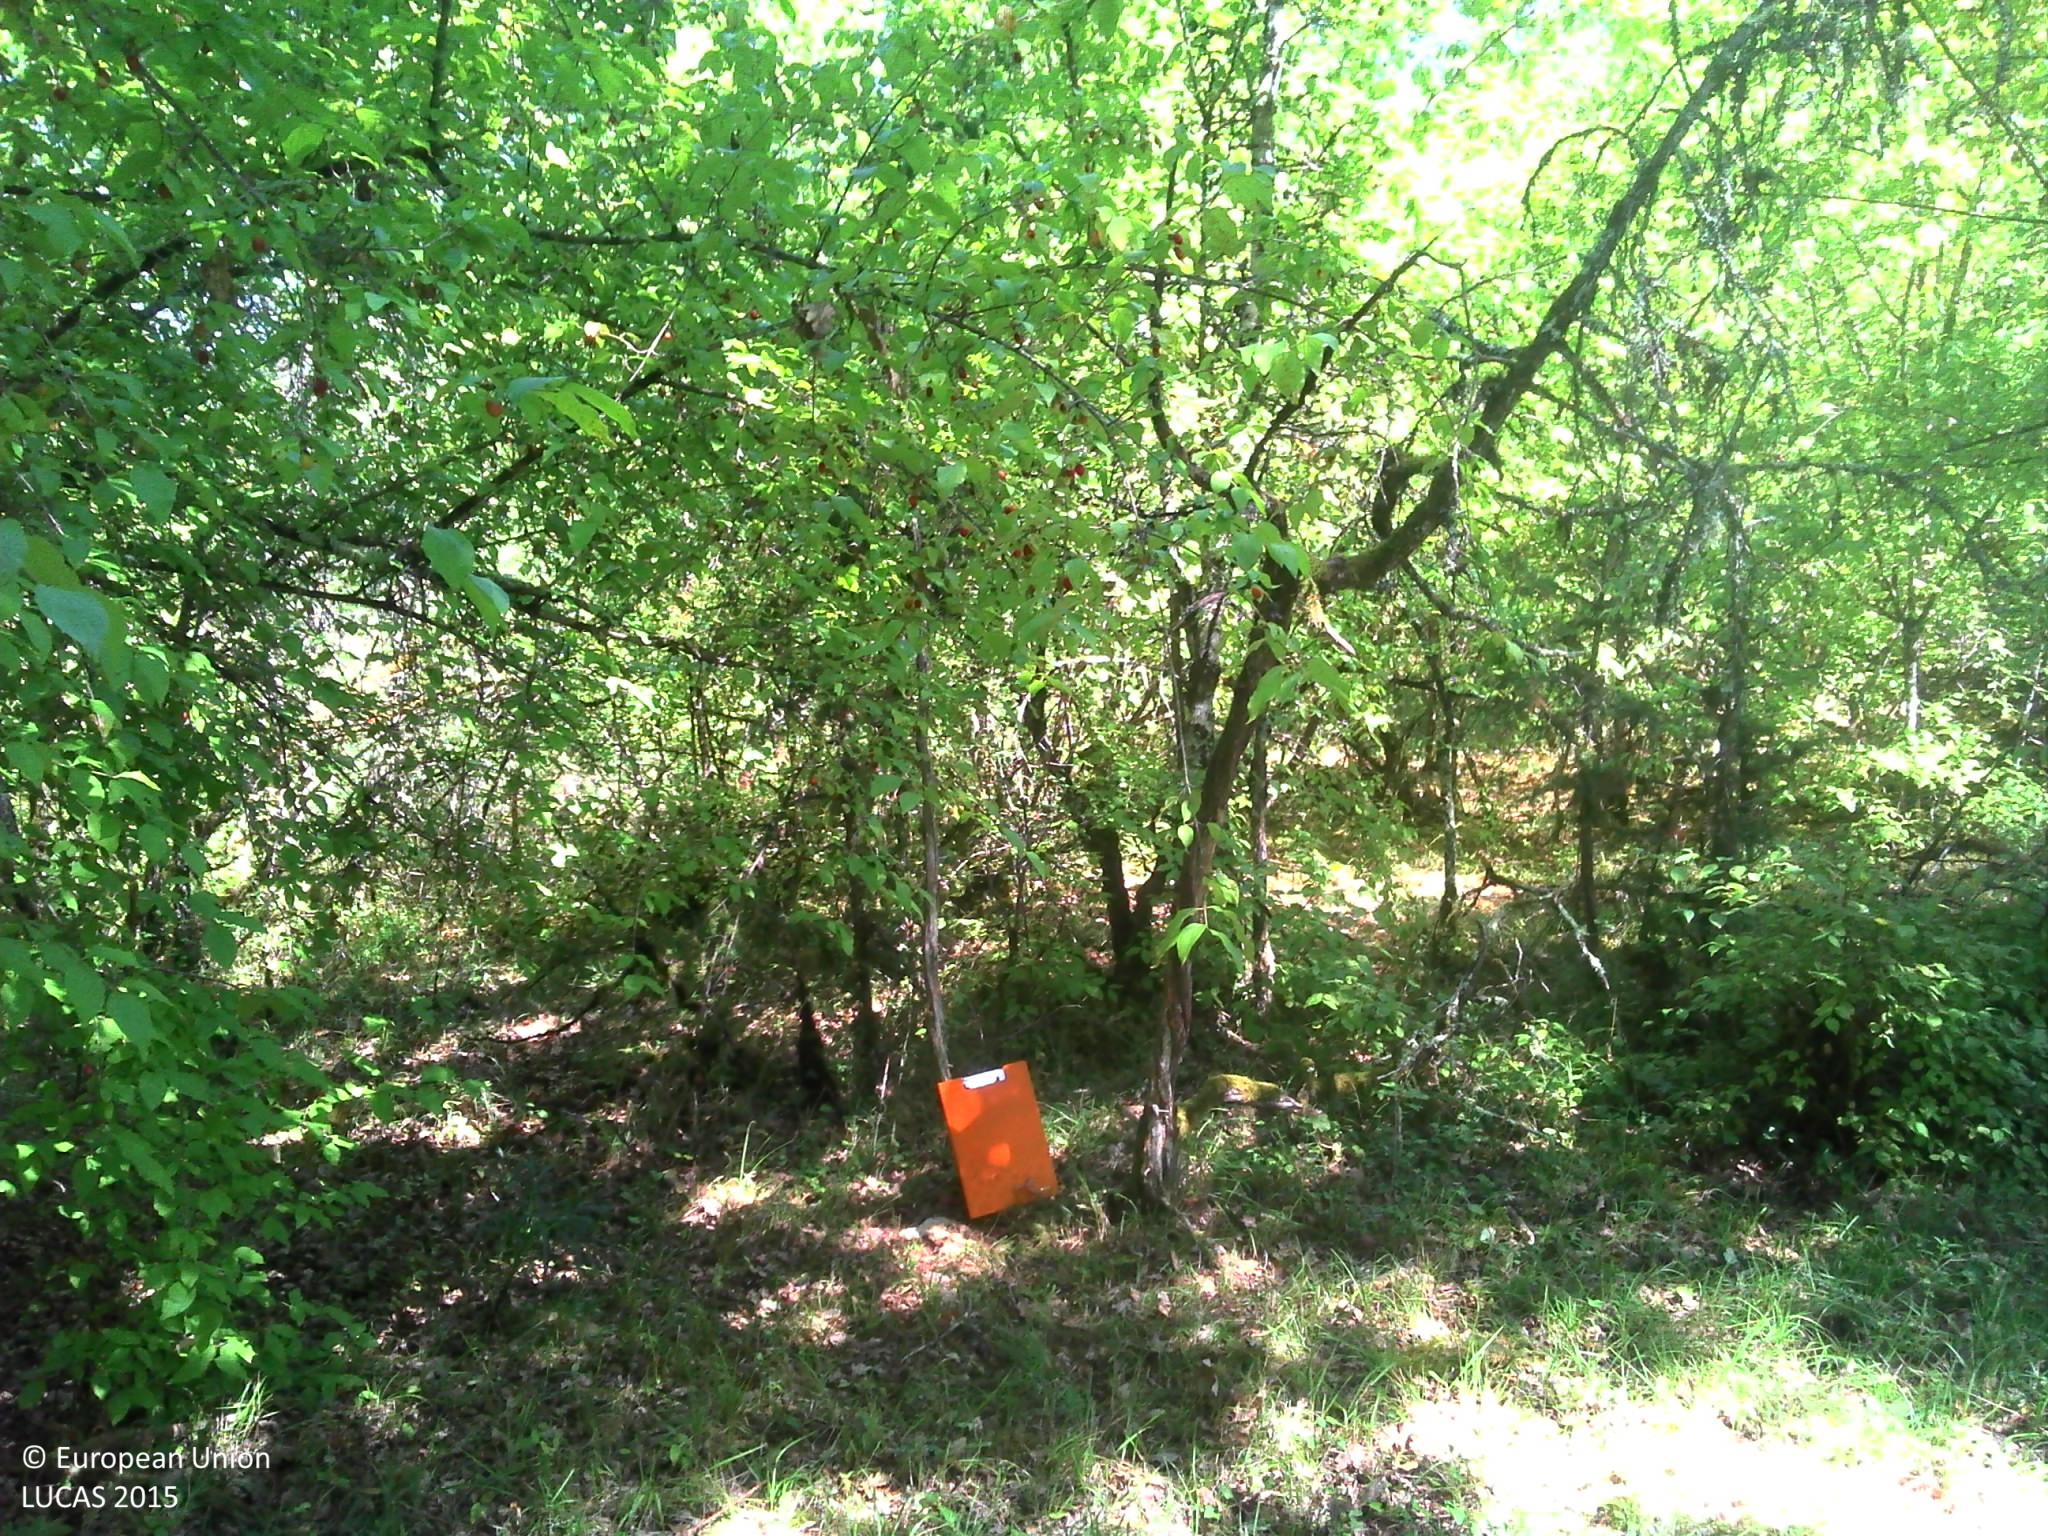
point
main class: Woodland
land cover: Broadleaved woodland
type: mesophytic deciduous forest
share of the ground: > 75 %
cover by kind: broadleaved forest trees 60 %, shrubs 30 %, herbaceous plants 10 %
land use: Forestry
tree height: > 5 m
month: August
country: FR
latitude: 44.7306
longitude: 1.7784
